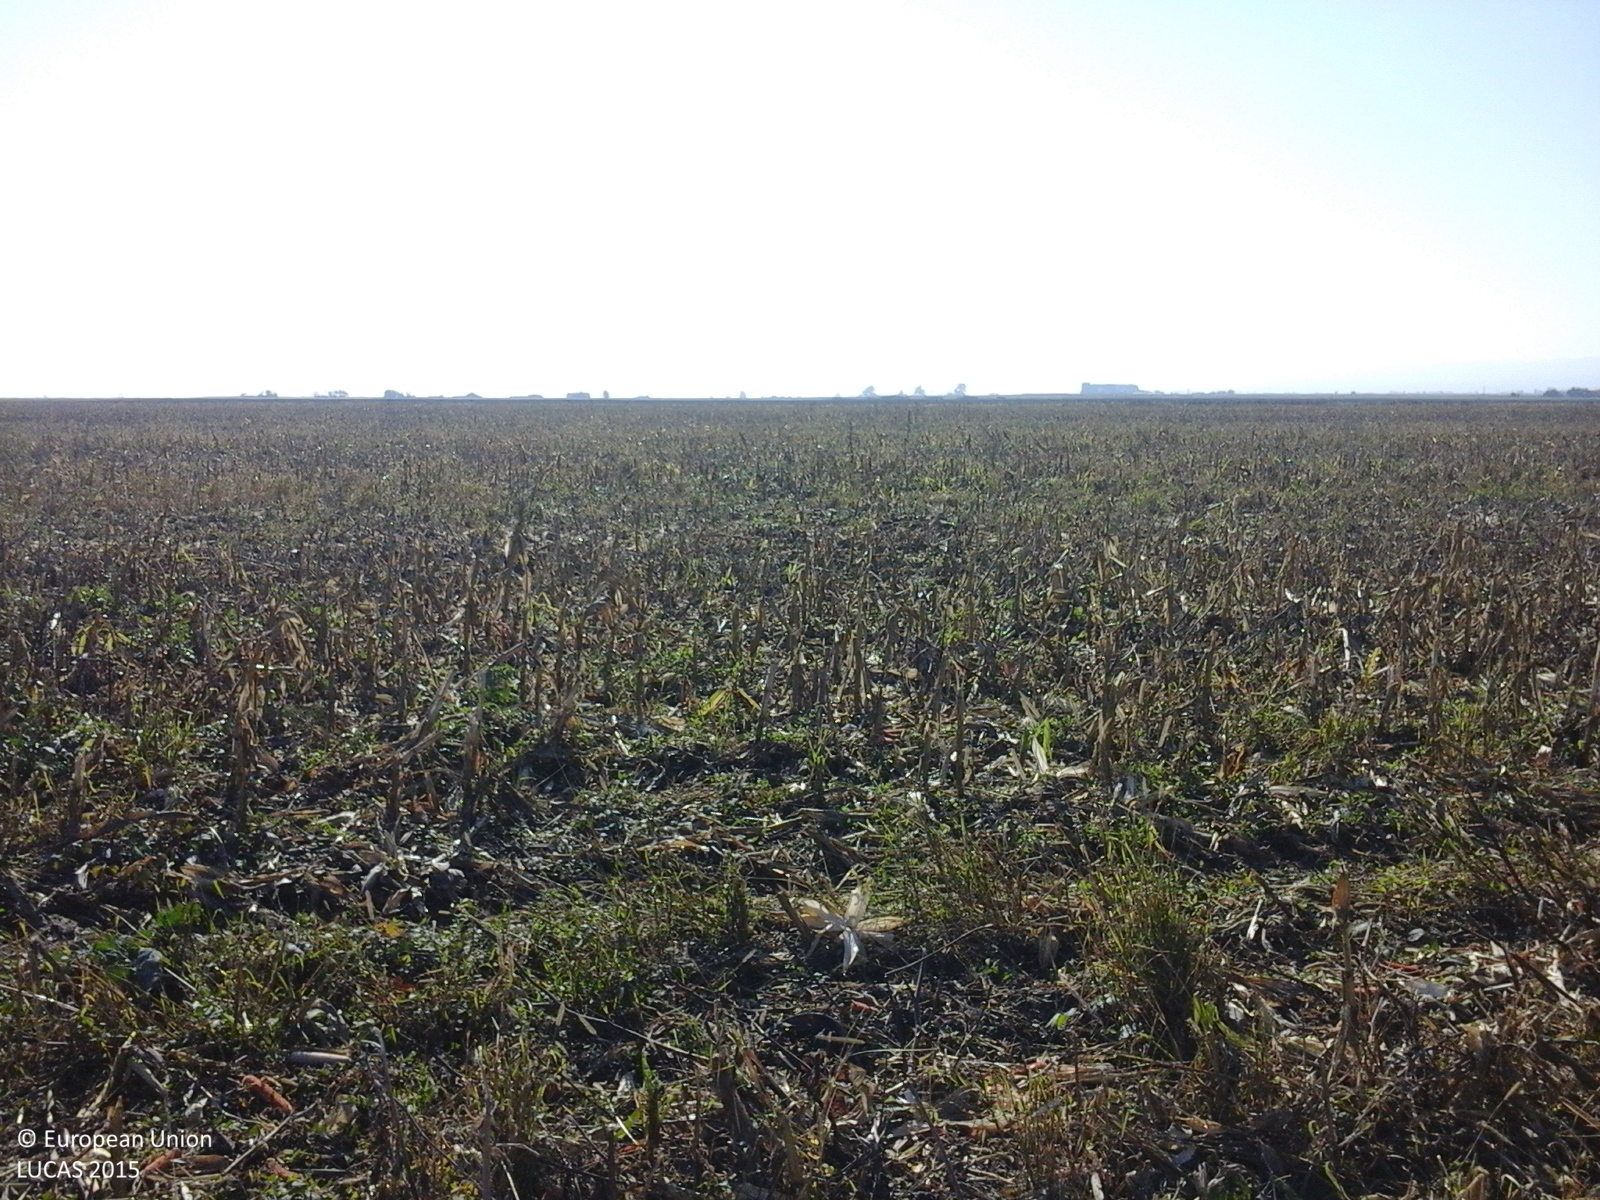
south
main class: Cropland
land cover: Maize
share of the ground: 50 - 75 %
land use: Agriculture (excluding fallow land and kitchen gardens)
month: October
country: RO
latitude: 45.7612
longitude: 27.1561
